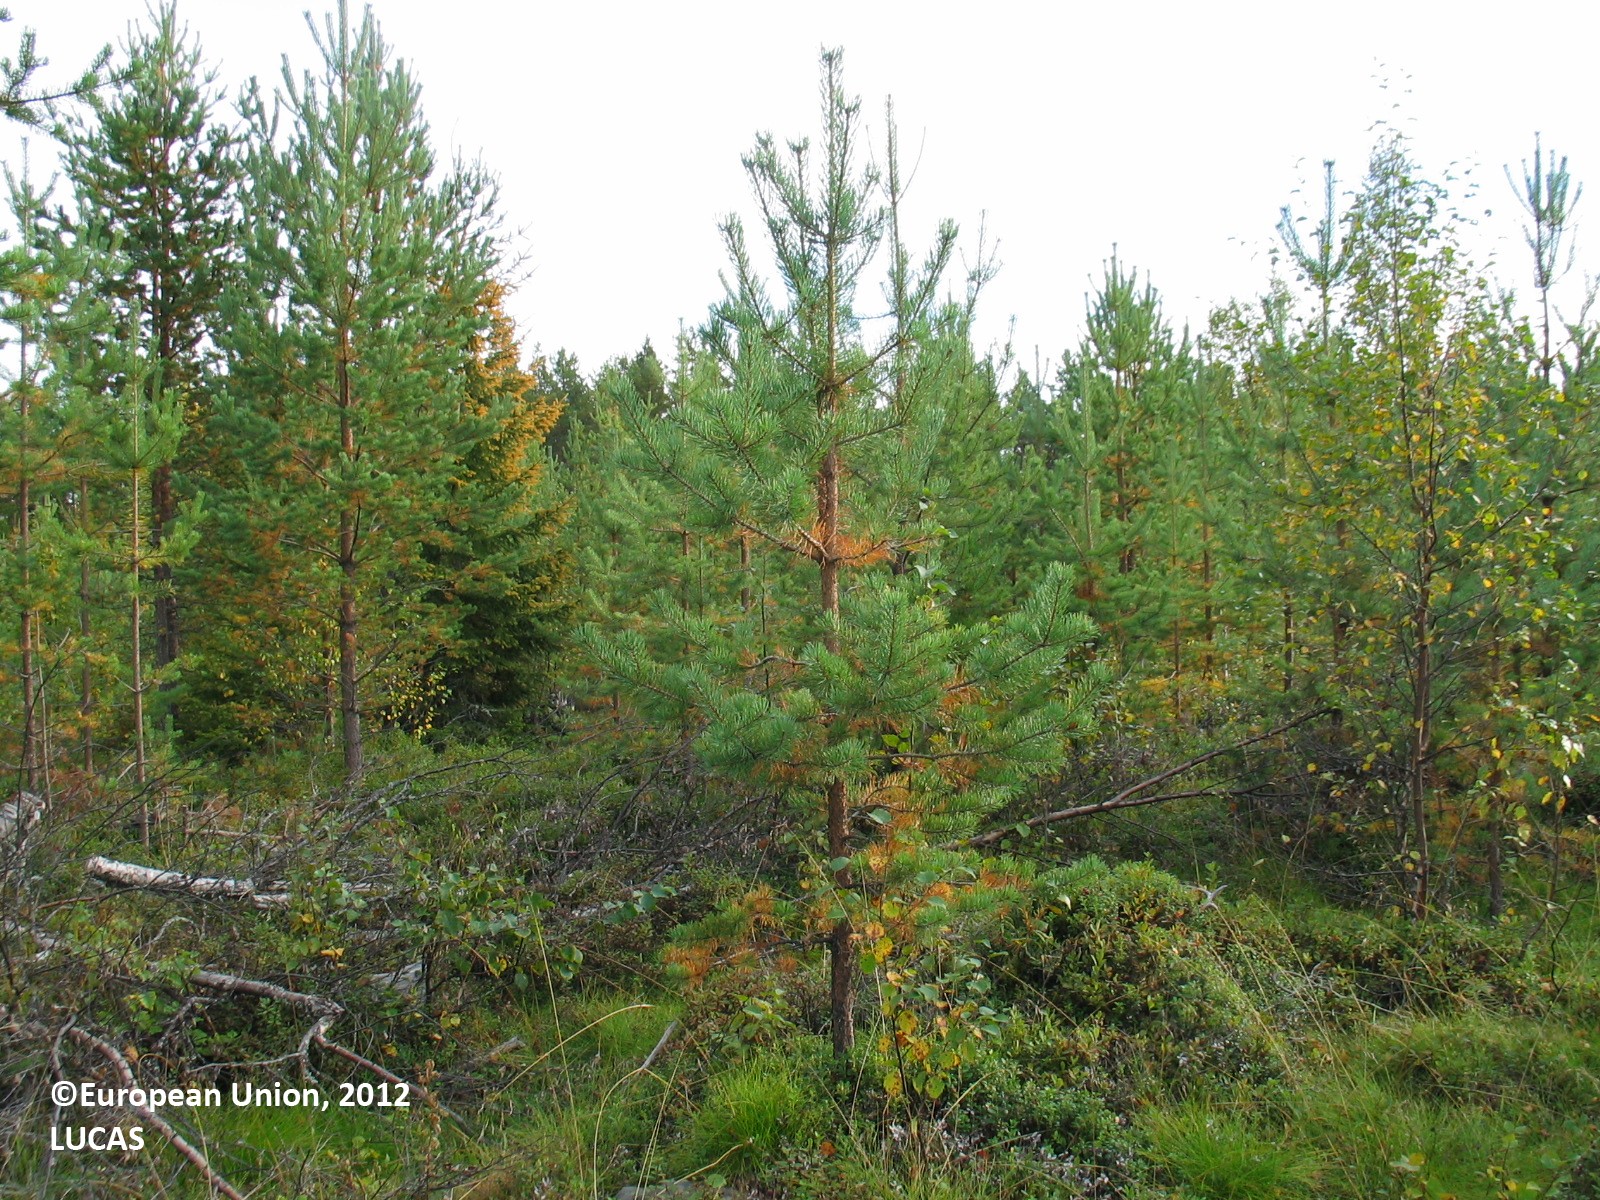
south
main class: Woodland
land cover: Pine dominated coniferous woodland
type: boreal forest
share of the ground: 50 - 75 %
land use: Forestry
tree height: < 5 m
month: September
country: FI
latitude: 65.2517
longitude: 25.5601
